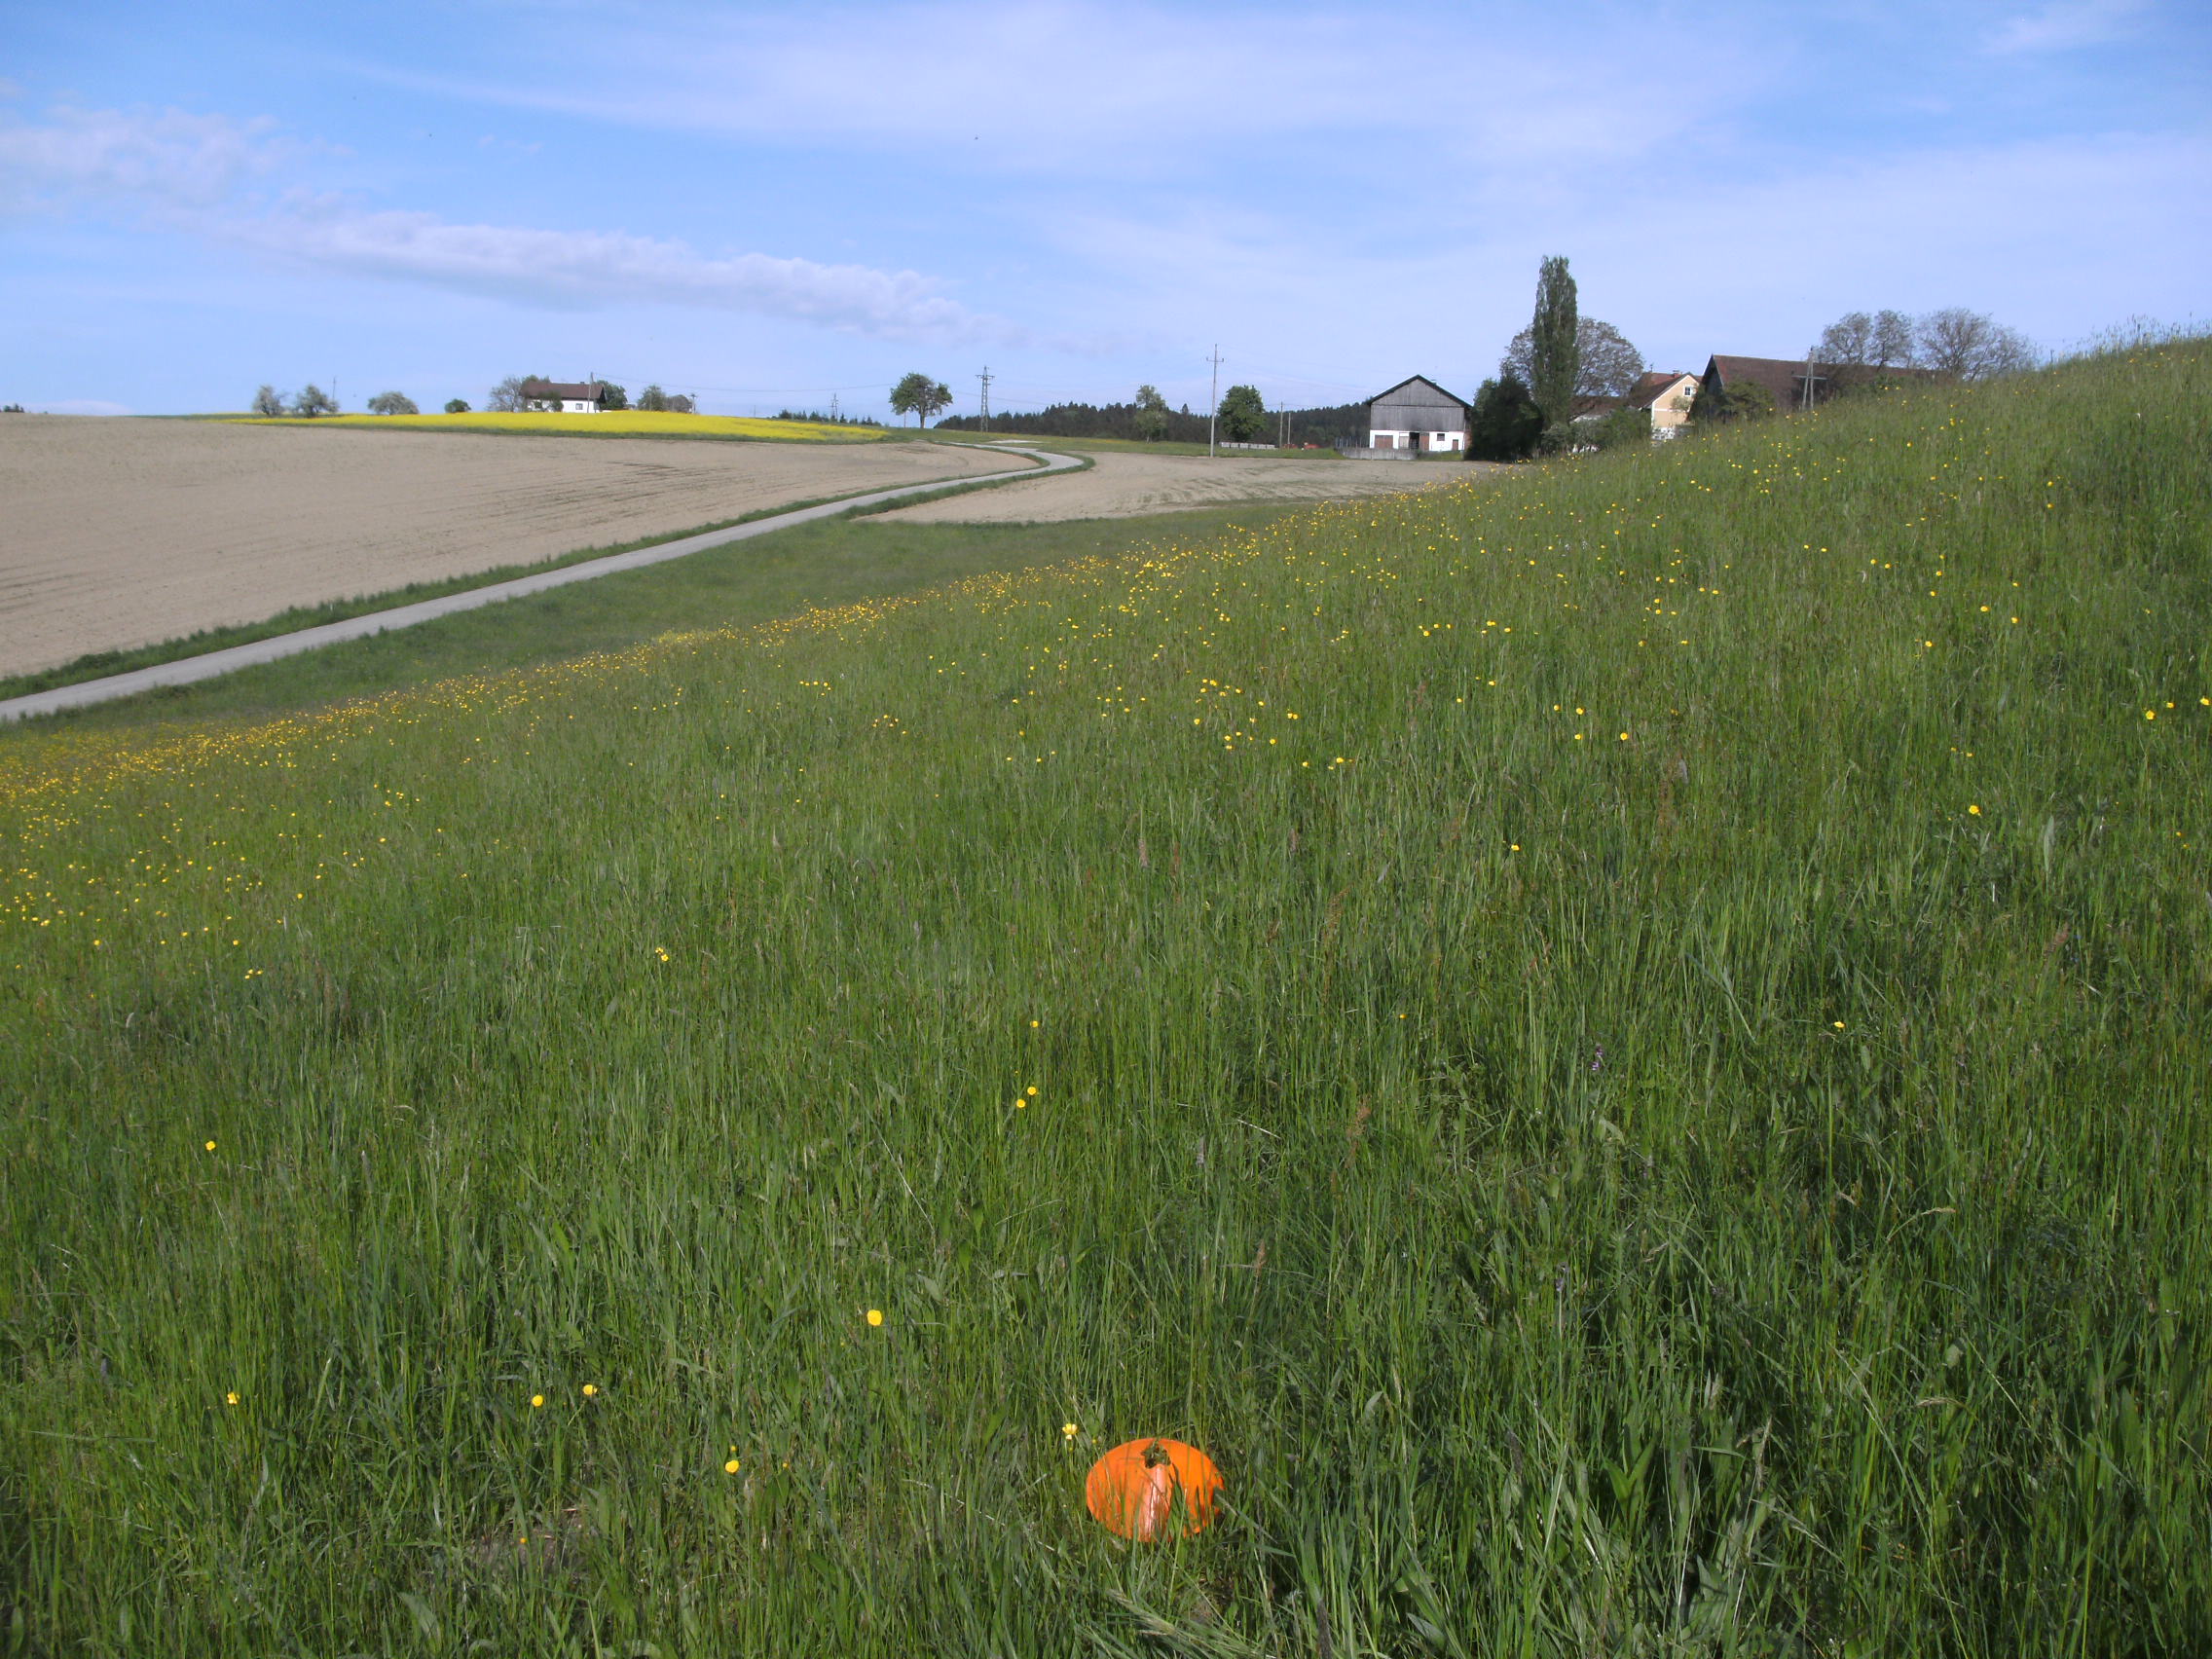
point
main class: Grassland
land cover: Grassland without tree/shrub cover
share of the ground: > 75 %
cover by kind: herbaceous plants 100 %
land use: Agriculture (excluding fallow land and kitchen gardens)
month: May
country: AT
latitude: 48.4921
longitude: 13.5042
